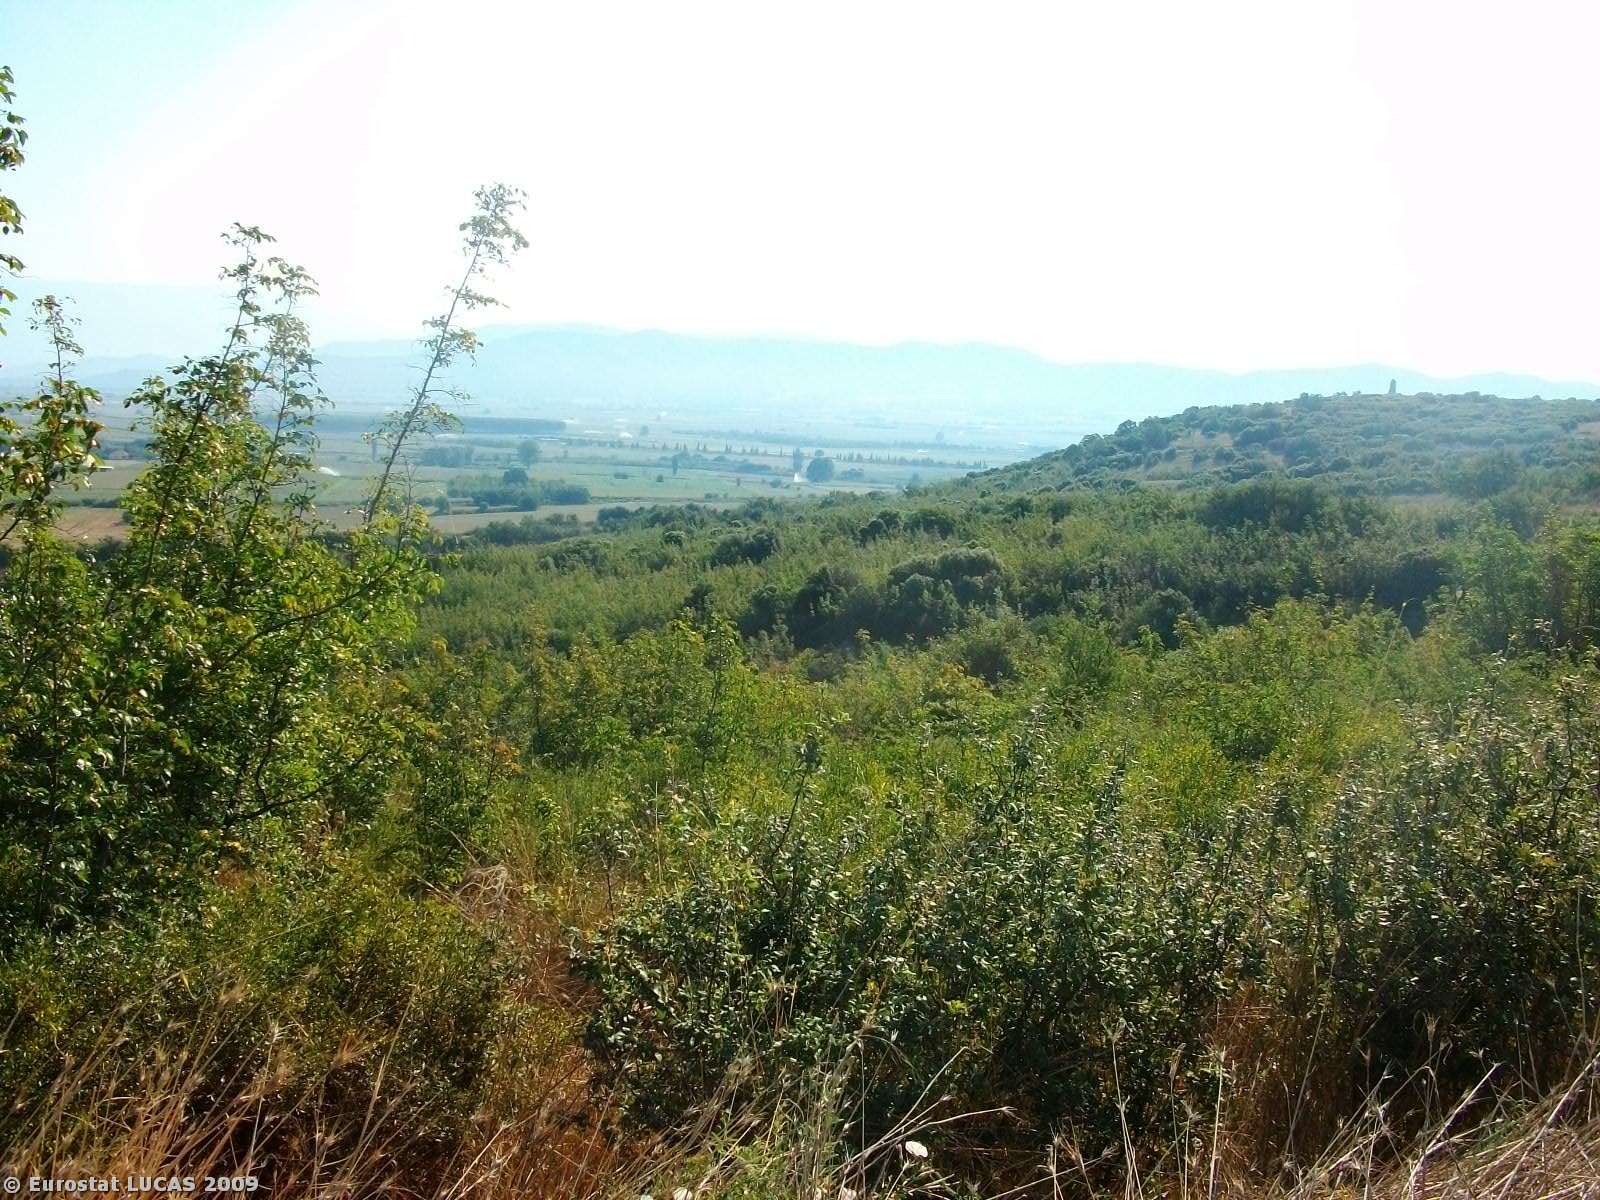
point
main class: Shrubland
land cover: Shrubland without tree cover
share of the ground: > 75 %
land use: Unused
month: July
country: GR
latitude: 41.1685
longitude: 22.7522
